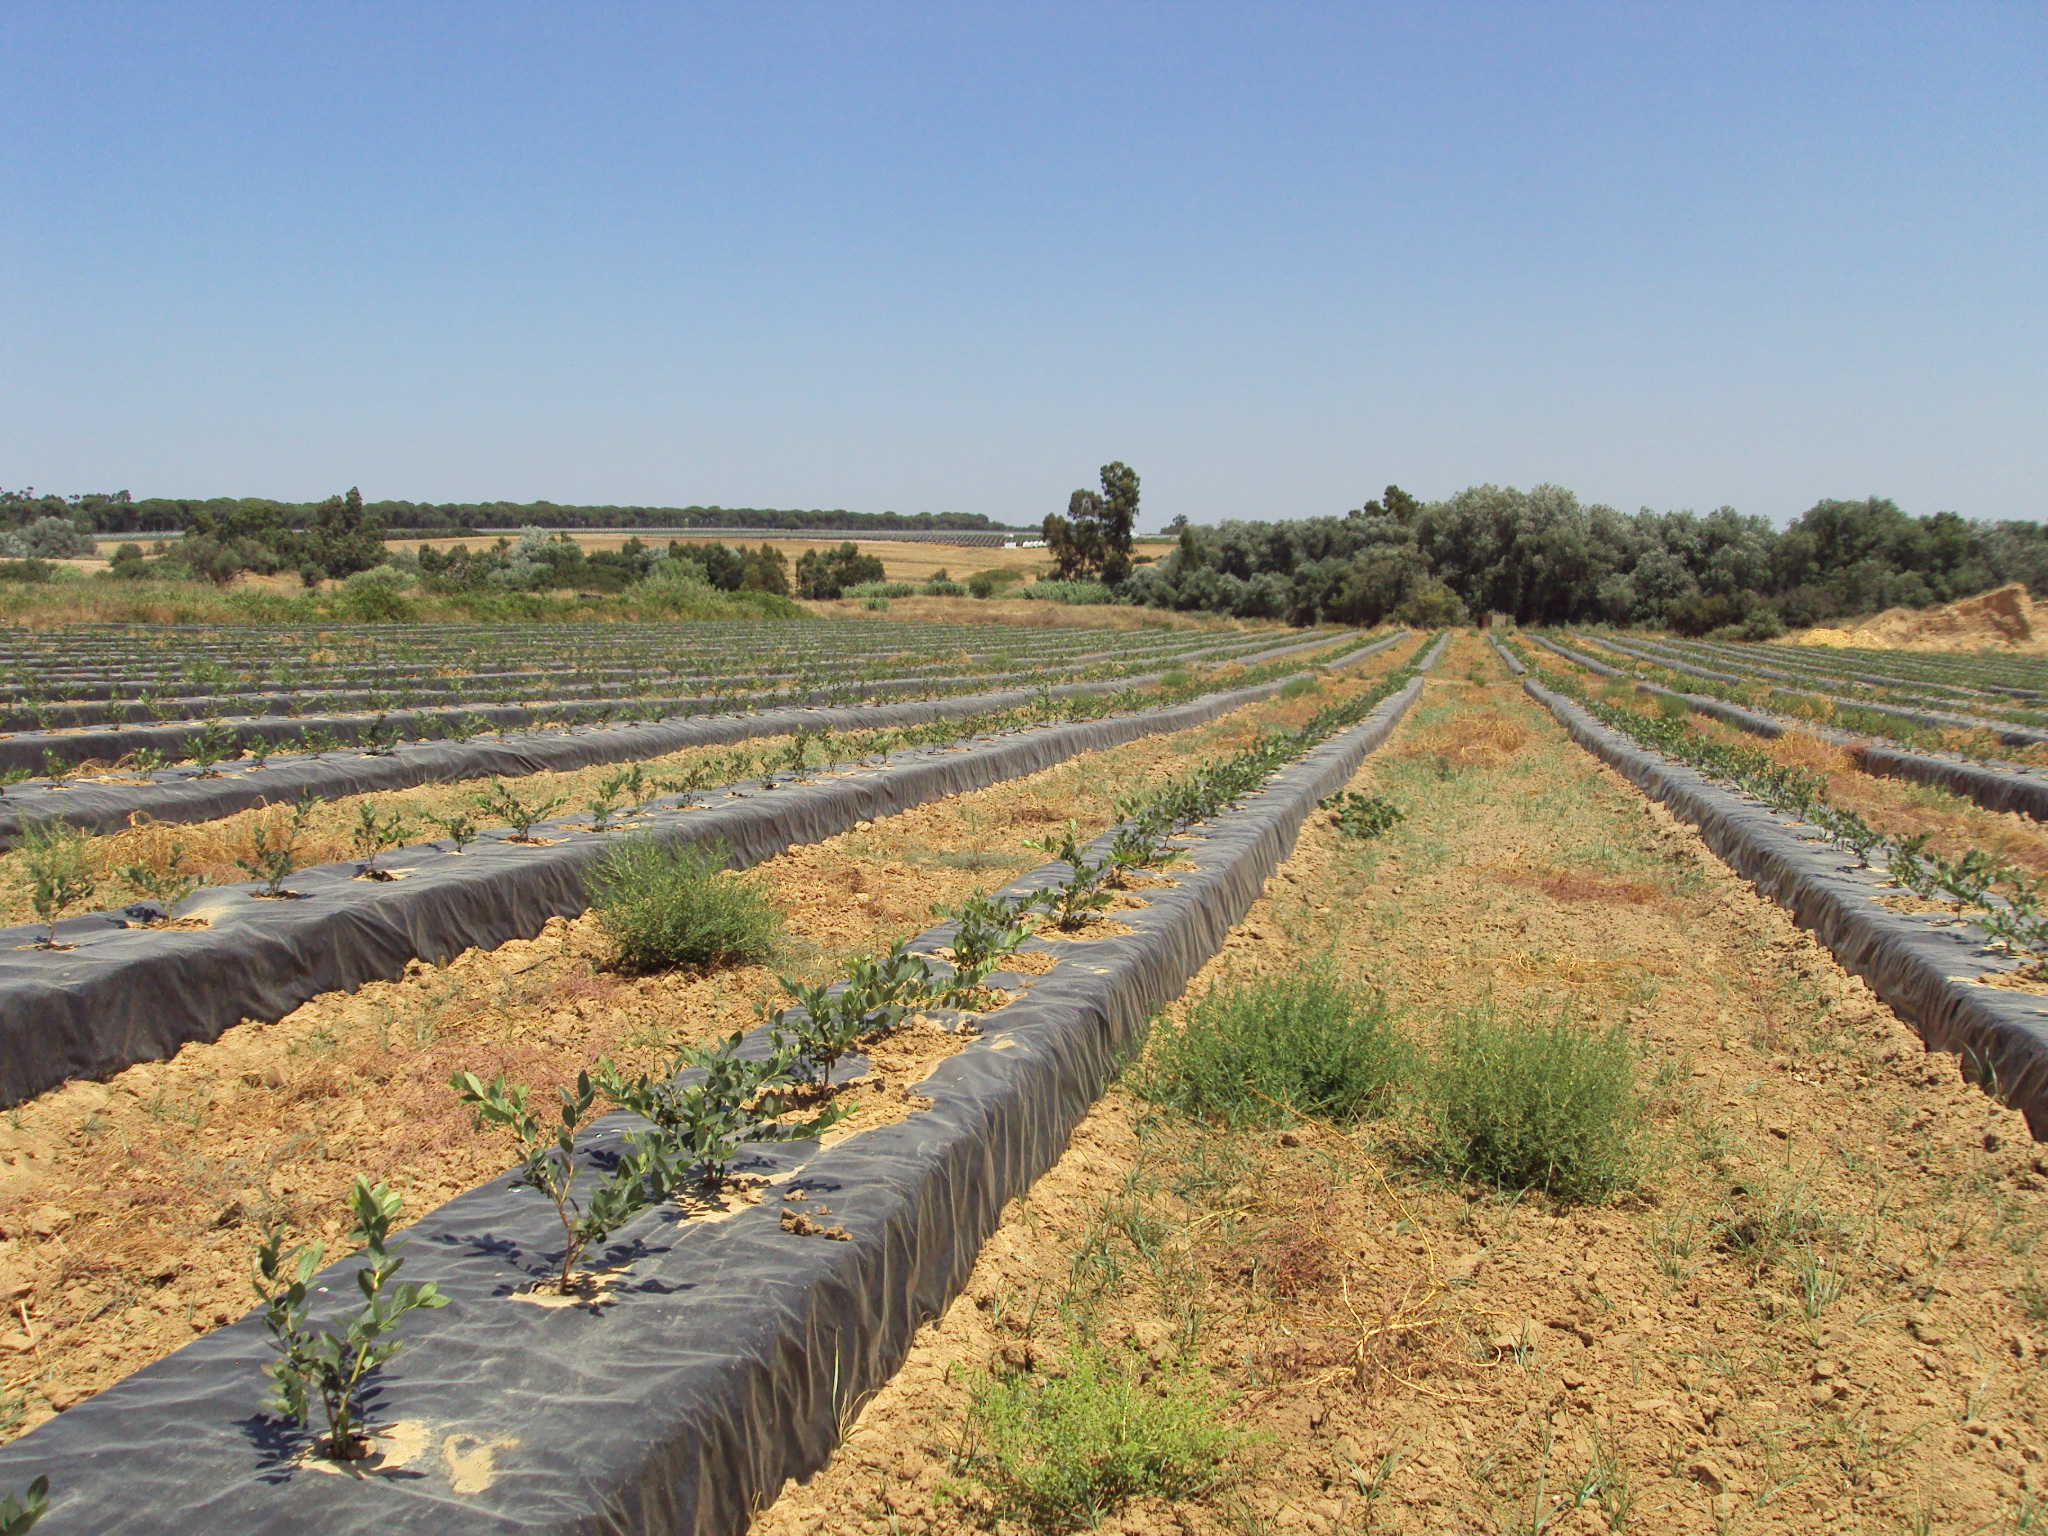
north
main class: Cropland
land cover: Other fruit trees and berries
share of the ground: 10 - 25 %
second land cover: Other bare soil
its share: > 75 %
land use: Agriculture (excluding fallow land and kitchen gardens)
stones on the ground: < 10 %
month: July
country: ES
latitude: 37.2569
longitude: -6.5946
